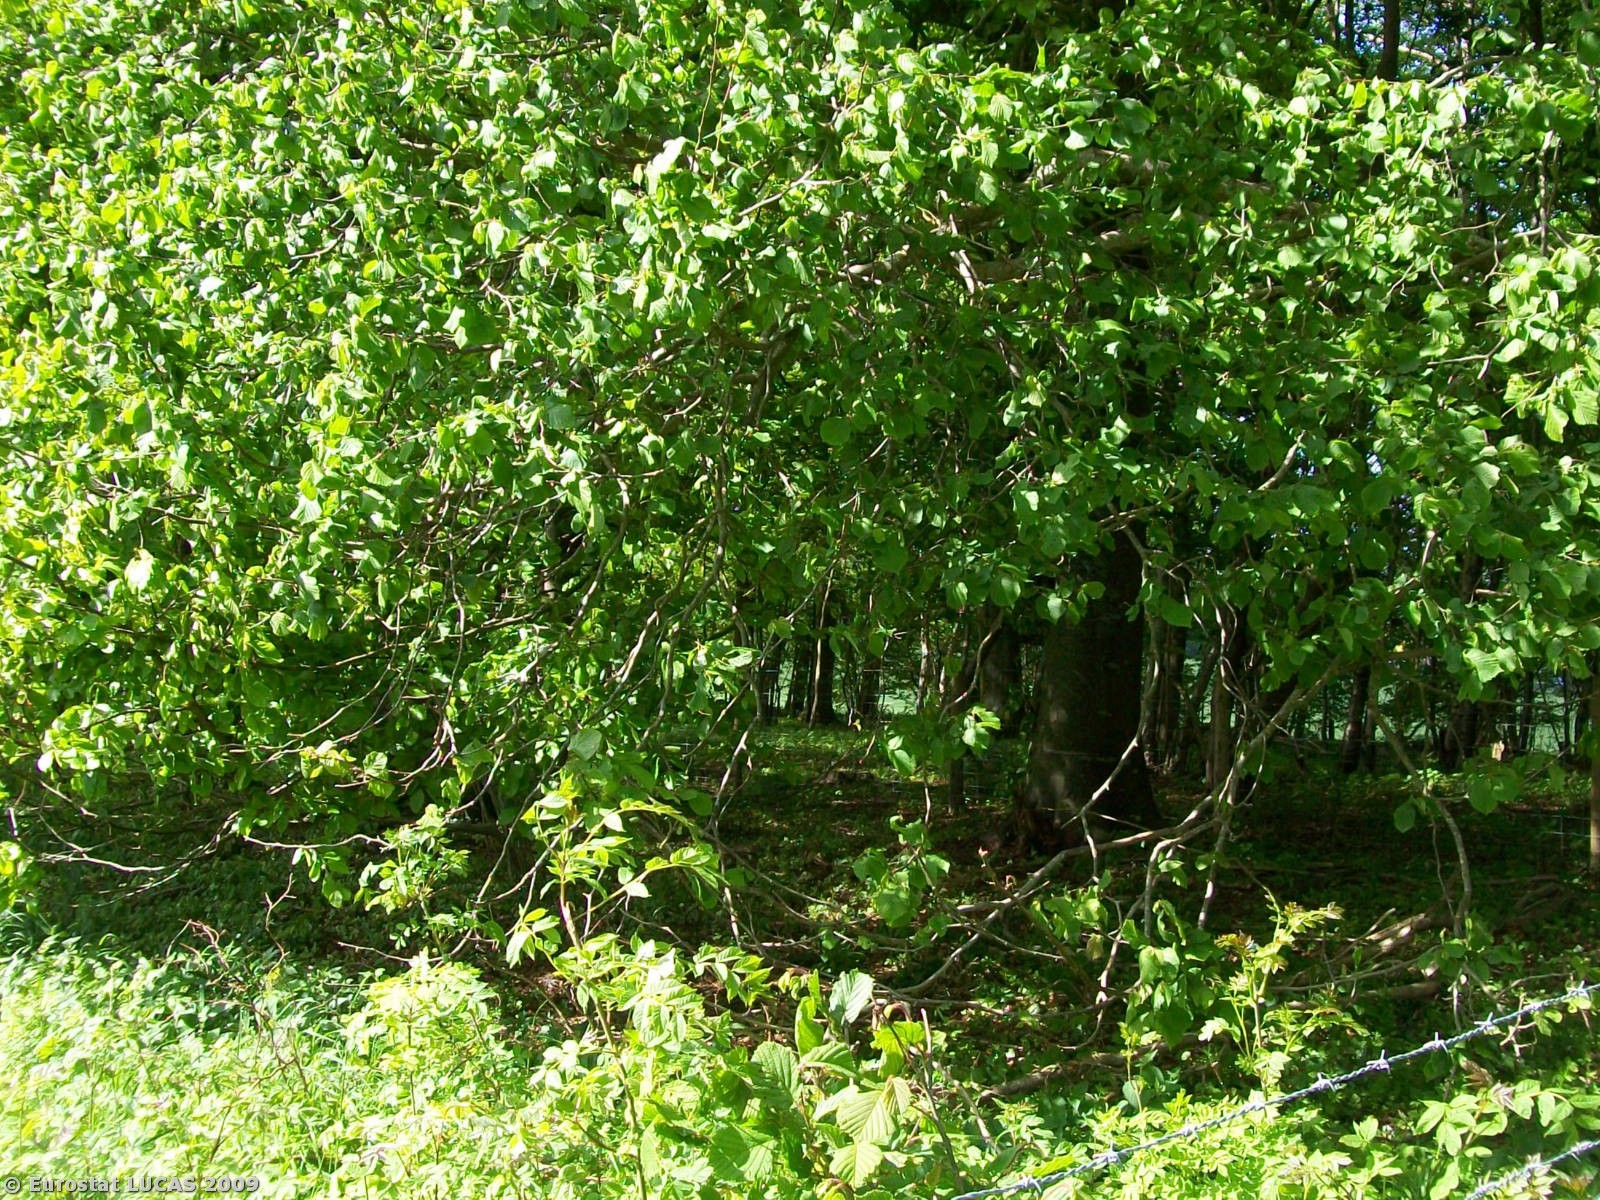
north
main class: Grassland
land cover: Grassland without tree/shrub cover
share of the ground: > 75 %
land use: Agriculture (excluding fallow land and kitchen gardens)
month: May
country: GB
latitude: 51.0775
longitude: -2.1504
